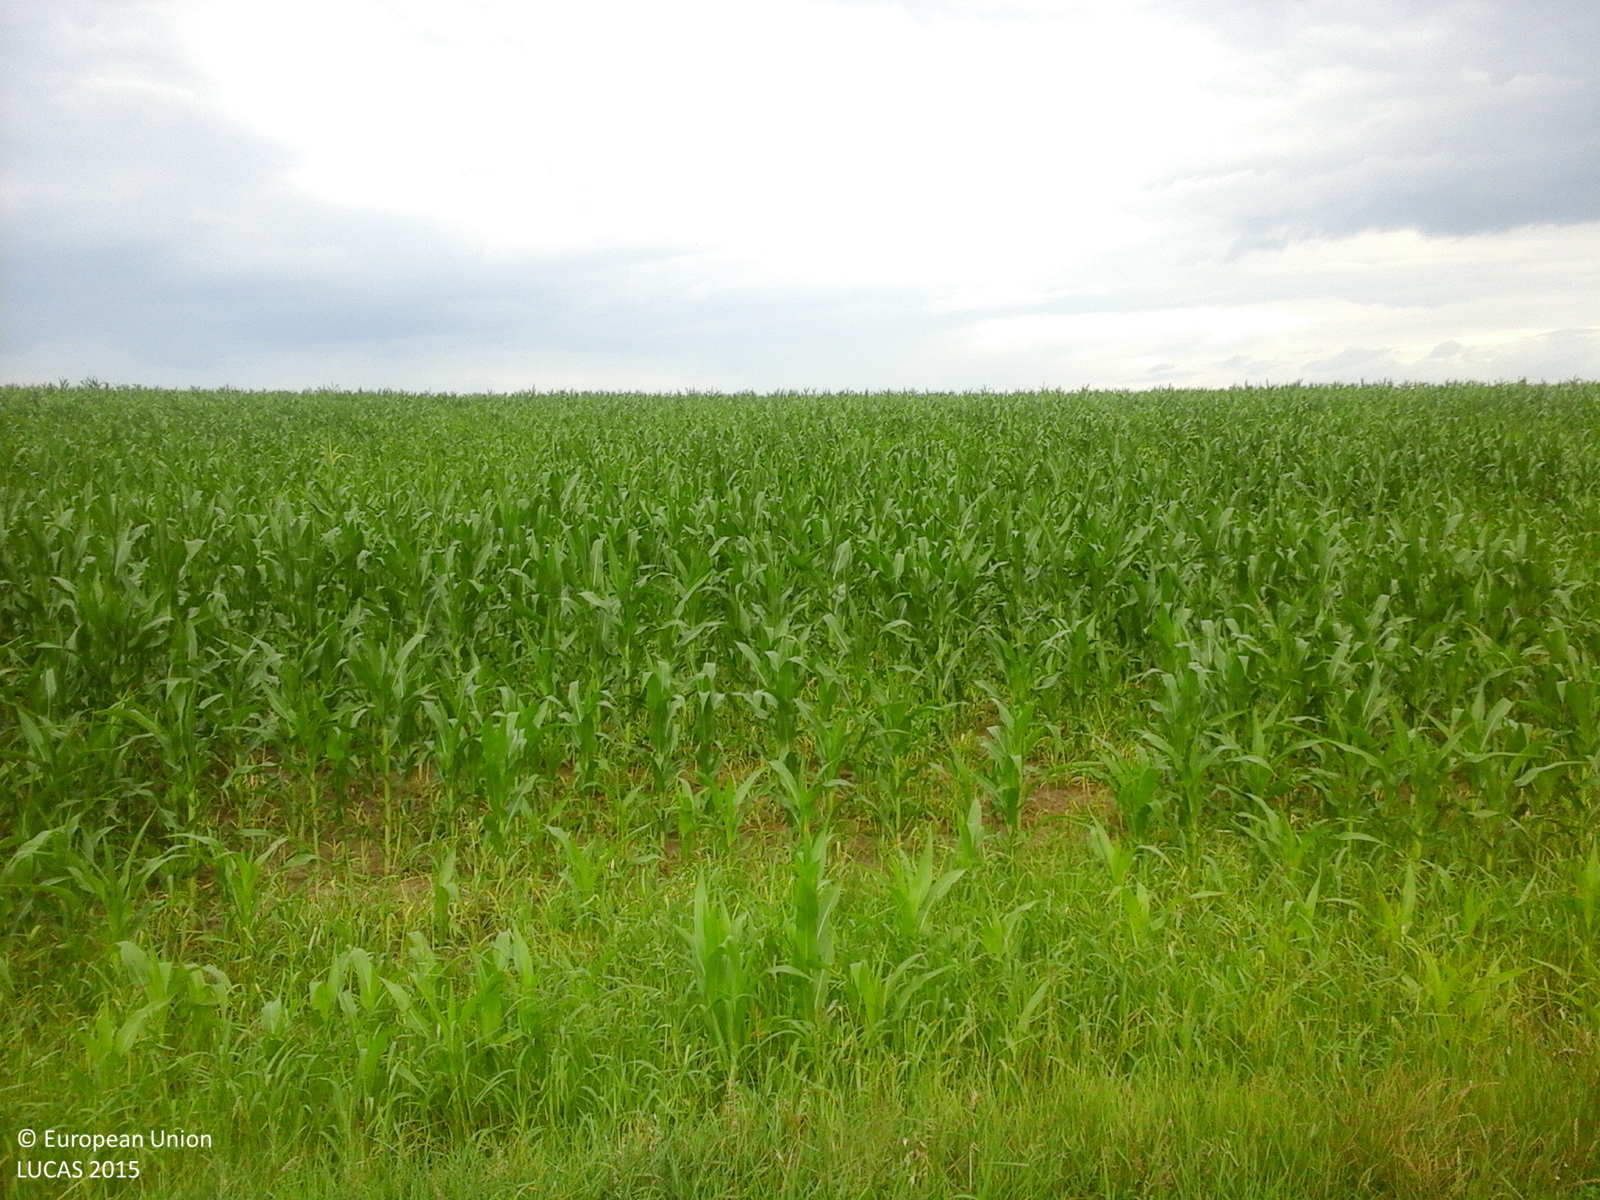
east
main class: Cropland
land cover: Maize
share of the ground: > 75 %
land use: Agriculture (excluding fallow land and kitchen gardens)
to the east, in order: Maize; Grass margins; Tracks; Maize
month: July
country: RO
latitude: 44.4375
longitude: 24.9163
